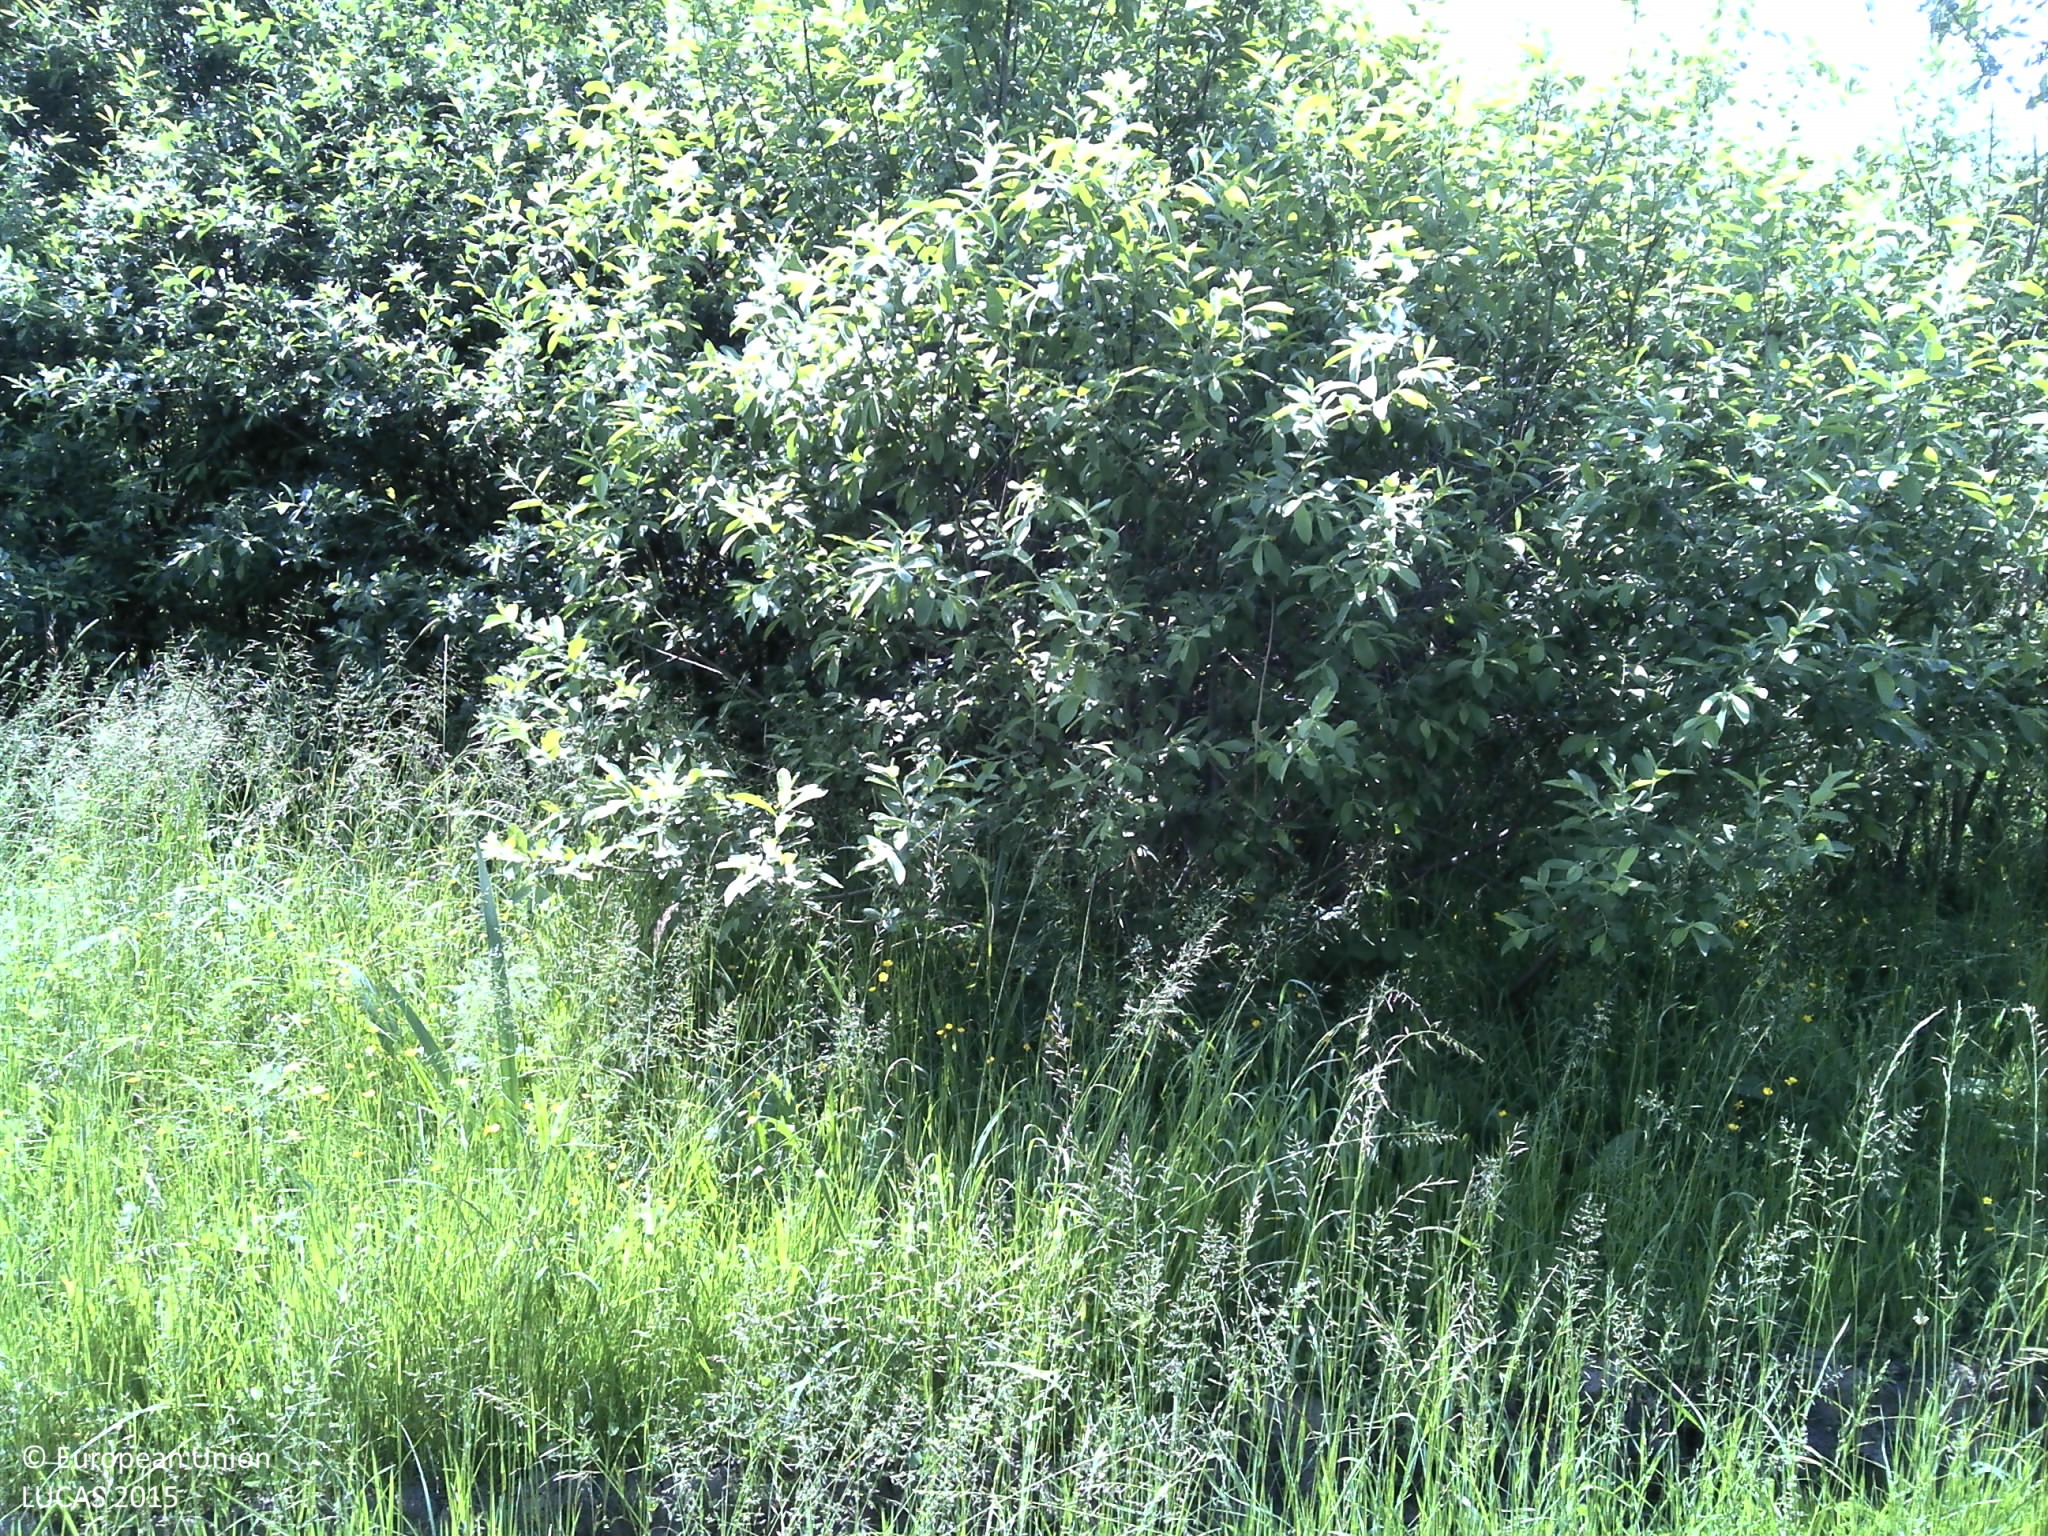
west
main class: Woodland
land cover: Broadleaved woodland
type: mesophytic deciduous forest
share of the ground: > 75 %
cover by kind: broadleaved forest trees 100 %
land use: Forestry
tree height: > 5 m
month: May
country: HR
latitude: 45.3013
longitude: 18.1015
